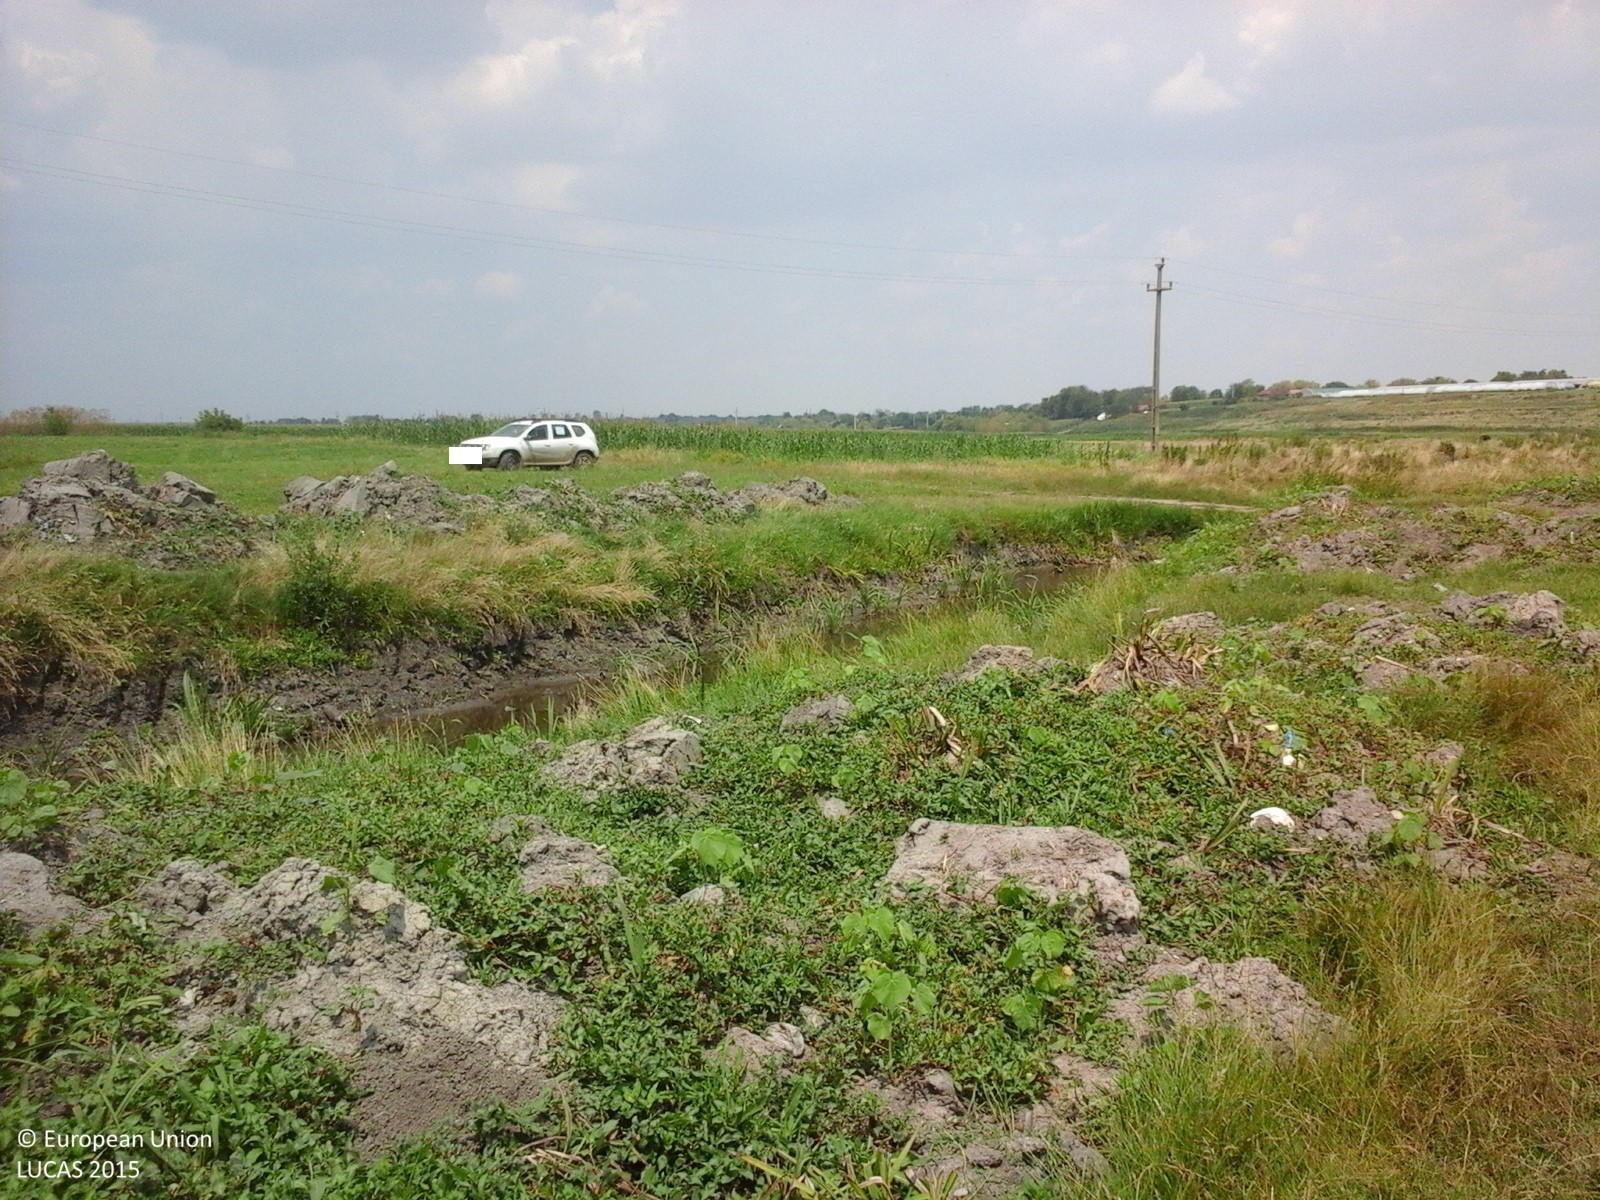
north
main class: Grassland
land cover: Grassland without tree/shrub cover
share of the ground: > 75 %
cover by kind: herbaceous plants 100 %
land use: Agriculture (excluding fallow land and kitchen gardens)
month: July
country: RO
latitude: 43.7981
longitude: 25.1535
